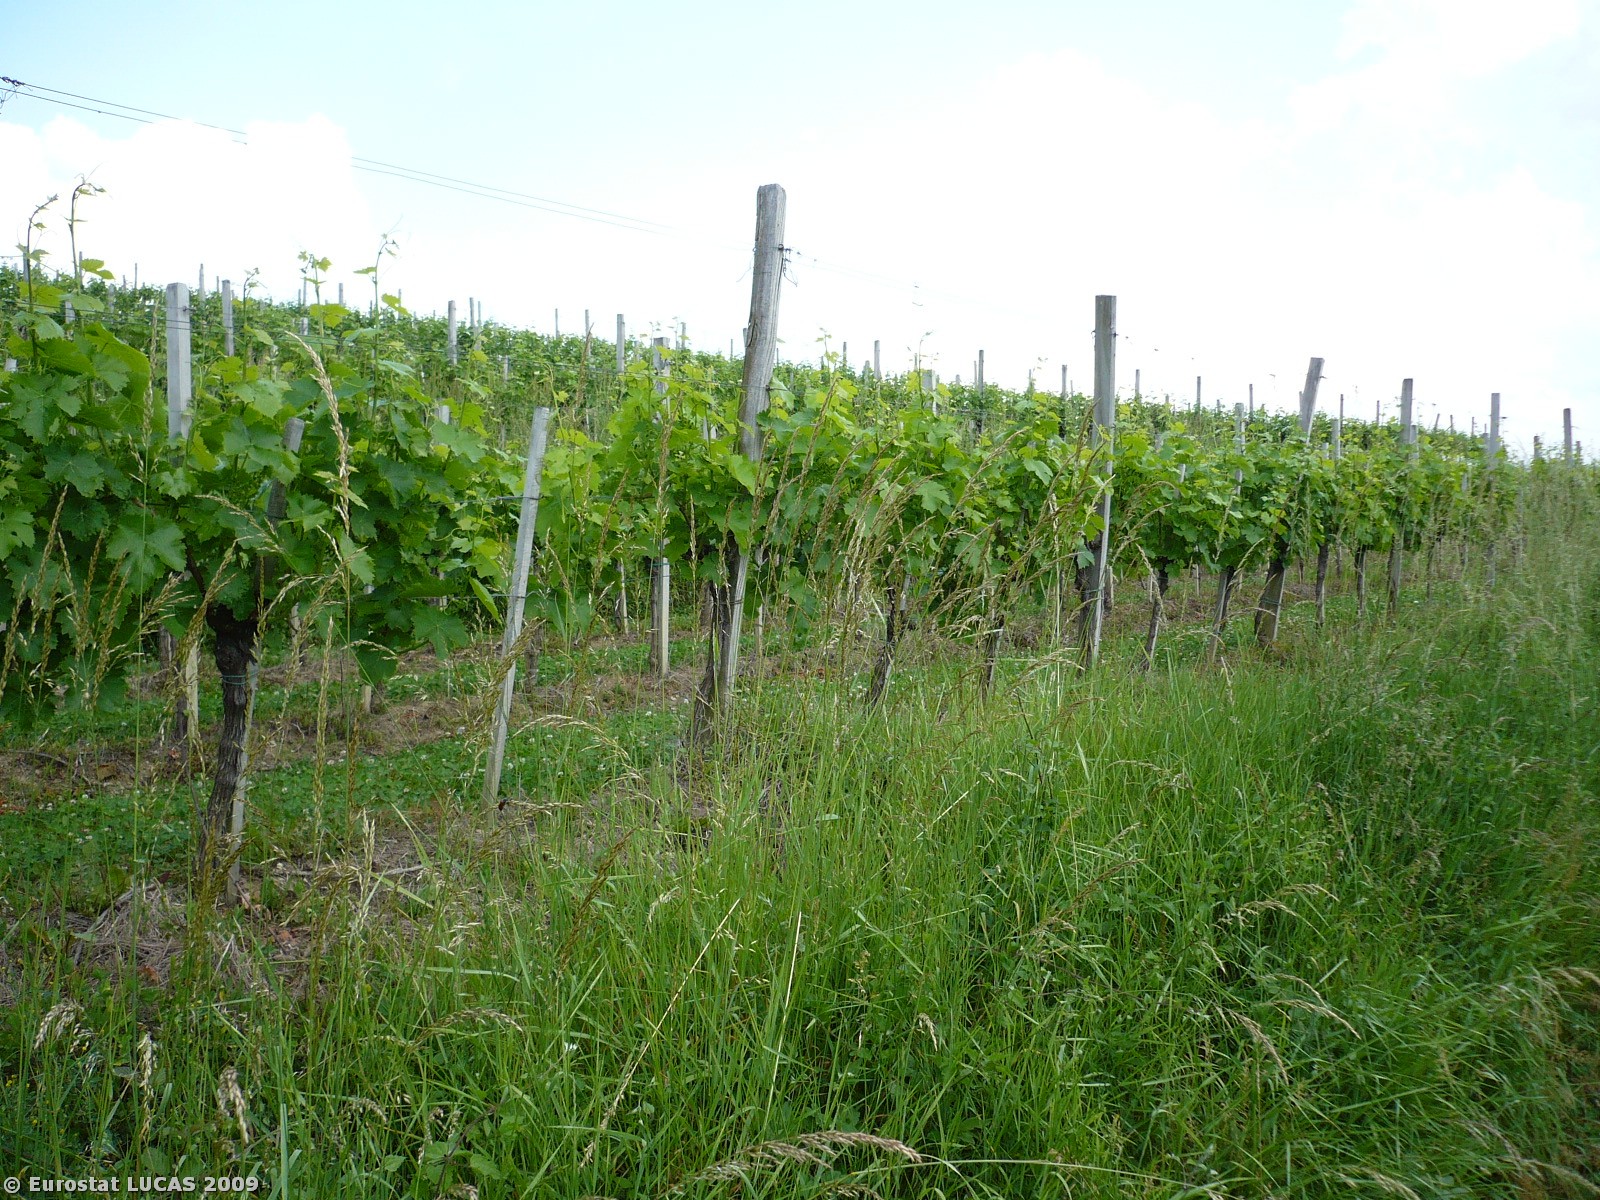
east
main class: Cropland
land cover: Vineyards
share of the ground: > 75 %
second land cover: Grassland with sparse tree/shrub cover
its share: > 75 %
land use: Agriculture (excluding fallow land and kitchen gardens)
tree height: < 5 m
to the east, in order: Vineyards; Grassland with sparse tree/shrub cover; Paved roads, cycling and walking lanes; Vineyards; Paved roads, cycling and walking lanes; Vineyards; Ditches and canals; Paved roads, cycling and walking lanes; Broadleaved woodland; Grassland without tree/shrub cover; Vineyards
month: May
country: SI
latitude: 45.9105
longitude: 13.6444
